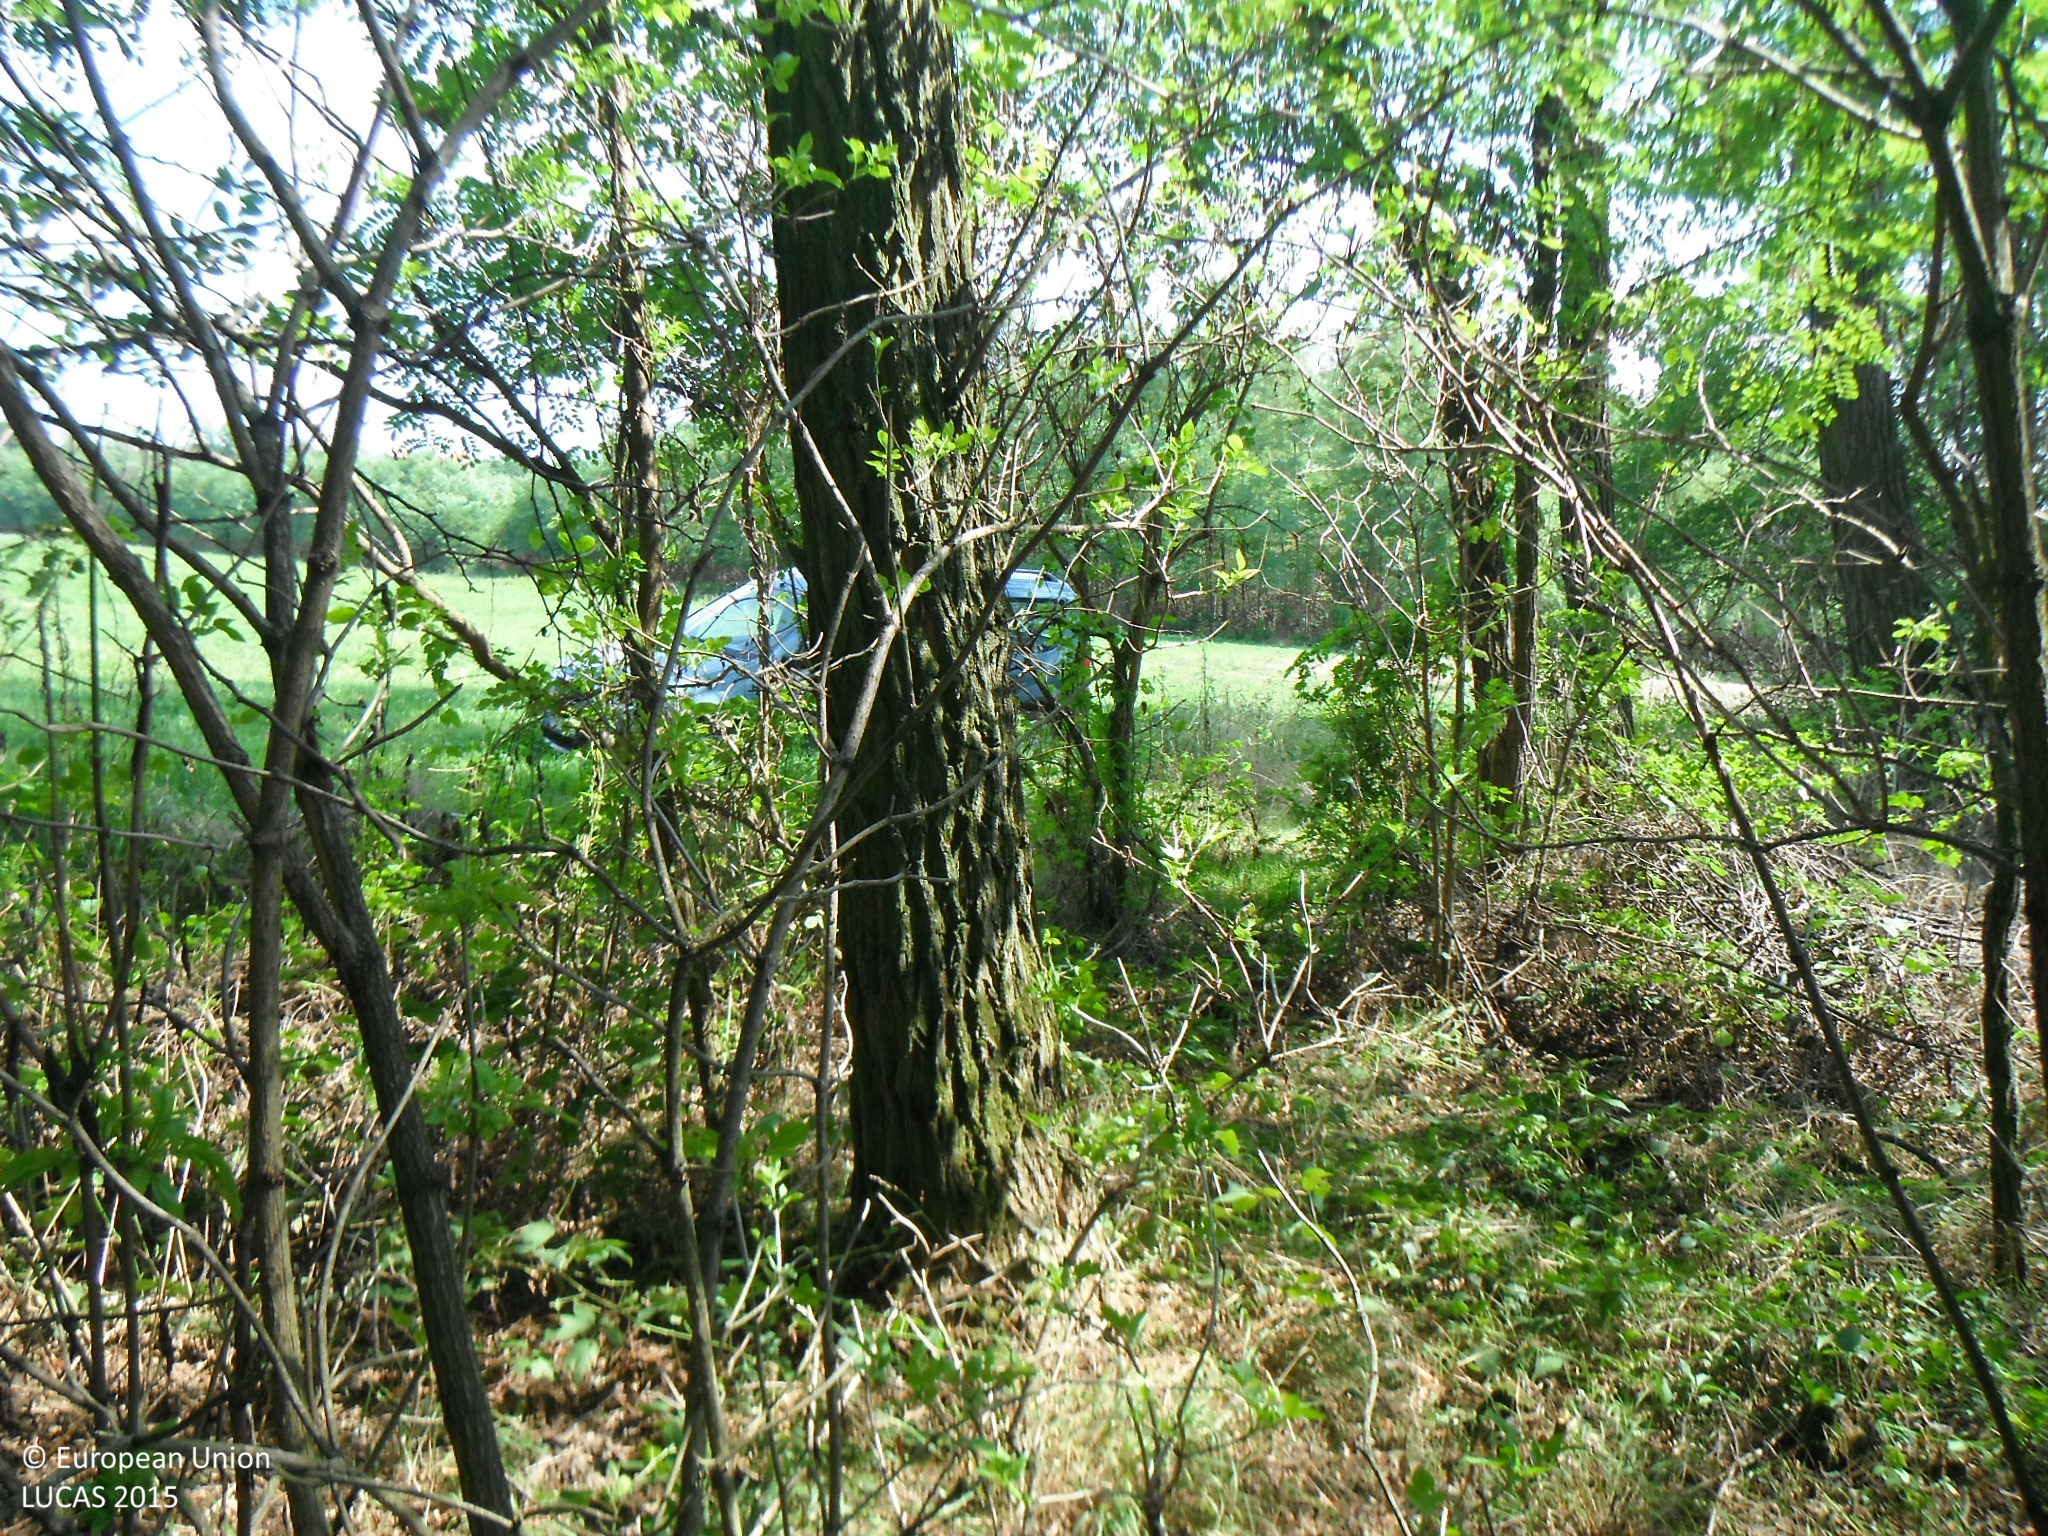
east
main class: Woodland
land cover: Broadleaved woodland
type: mesophytic deciduous forest
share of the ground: > 75 %
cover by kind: broadleaved forest trees 80 %, shrubs 10 %, herbaceous plants 10 %
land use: Forestry
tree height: > 5 m
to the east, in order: Broadleaved woodland; Grassland without tree/shrub cover; Tracks; Grassland without tree/shrub cover; Broadleaved woodland; Tracks
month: September
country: SK
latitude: 48.7124
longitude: 17.4448
